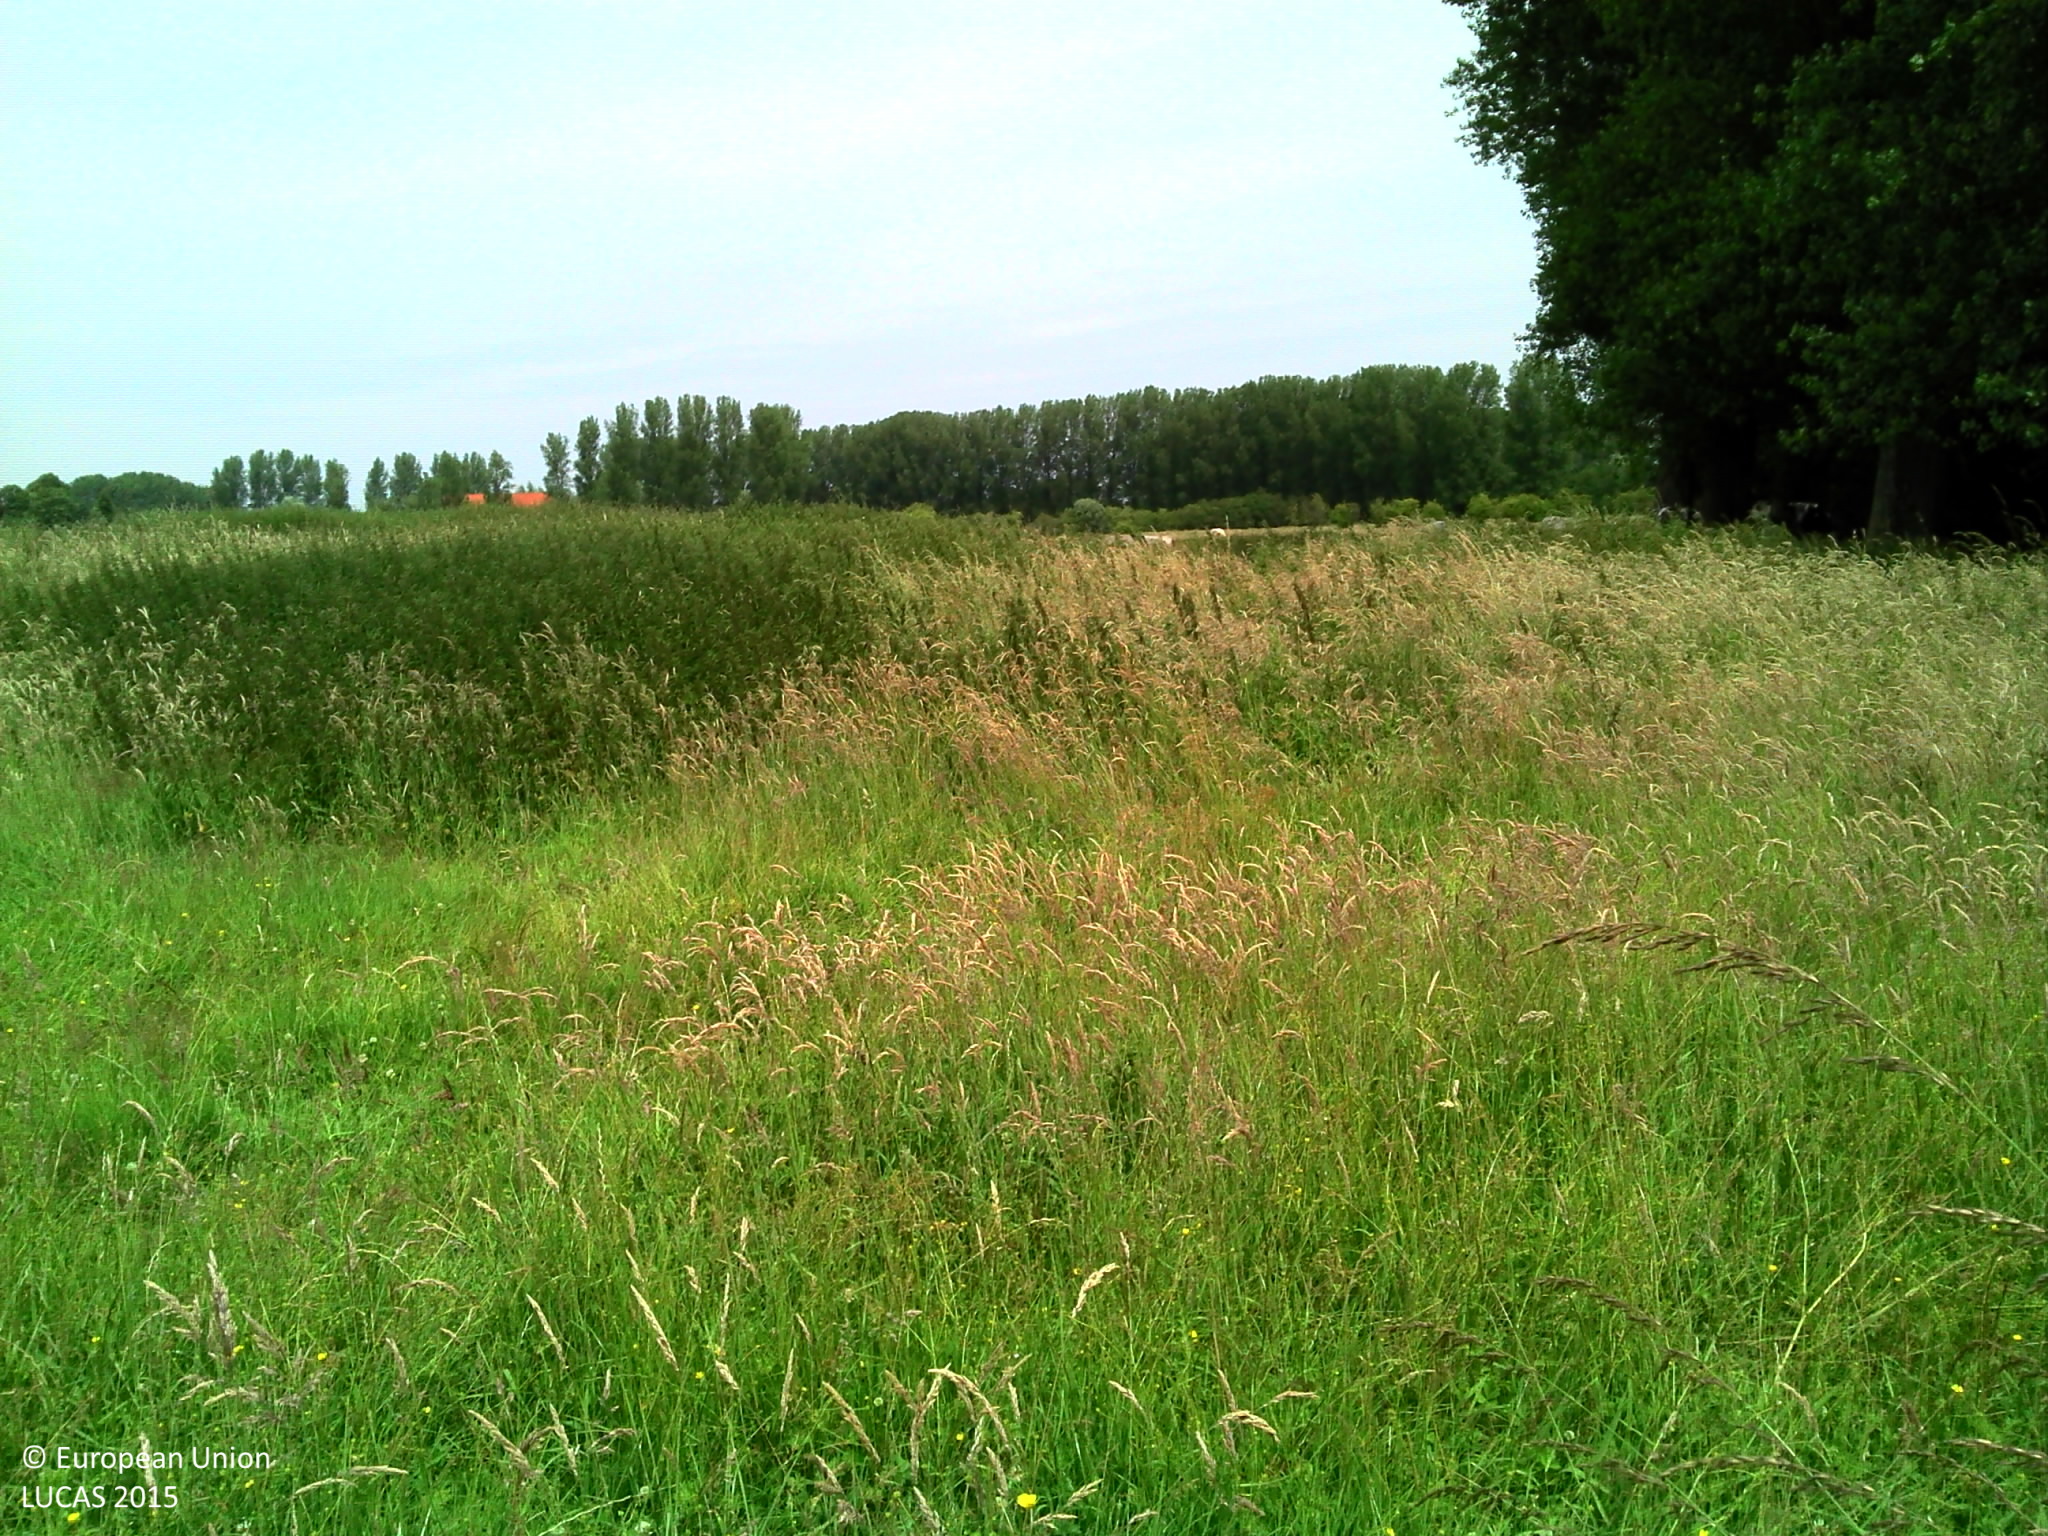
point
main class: Grassland
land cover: Grassland without tree/shrub cover
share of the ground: > 75 %
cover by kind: herbaceous plants 100 %
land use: Agriculture (excluding fallow land and kitchen gardens)
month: June
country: BE
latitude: 50.6459
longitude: 3.7850
